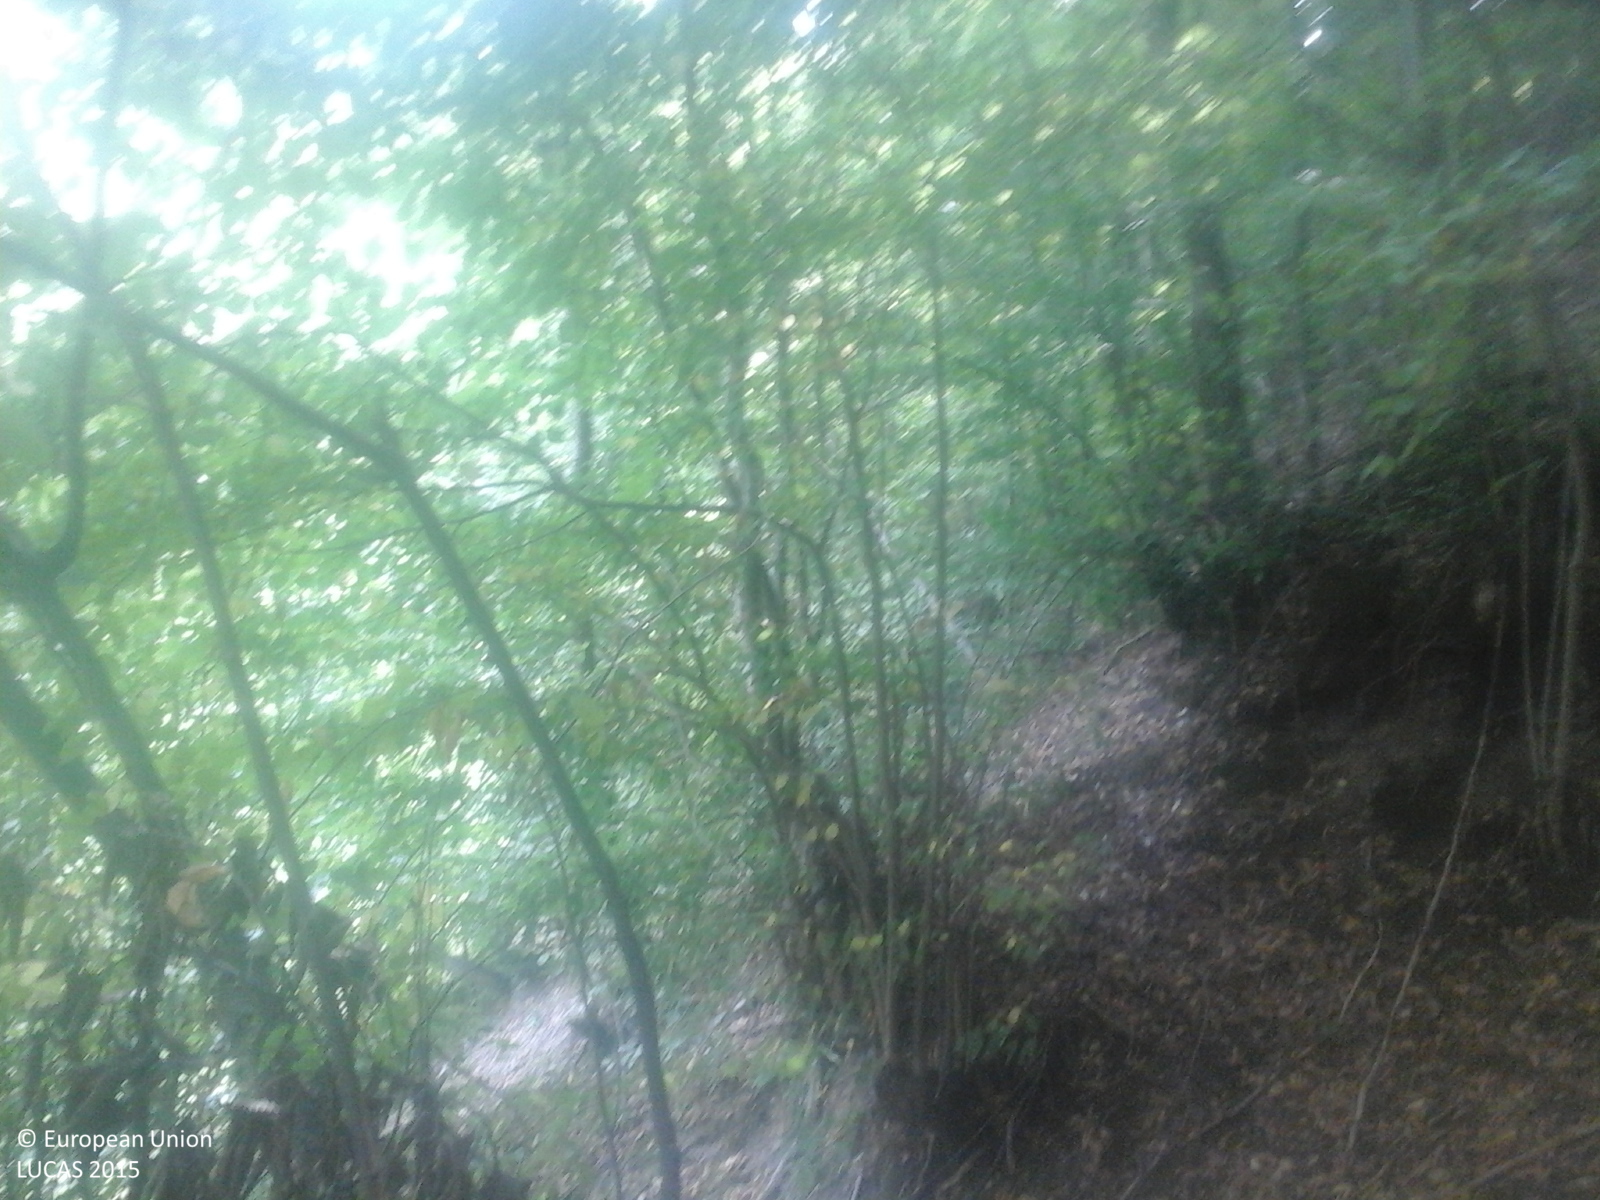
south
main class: Woodland
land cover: Broadleaved woodland
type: beech forest
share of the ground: > 75 %
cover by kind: broadleaved forest trees 100 %
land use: Forestry
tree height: > 5 m
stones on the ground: < 10 %
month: September
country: RO
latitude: 47.7112
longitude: 24.3941
